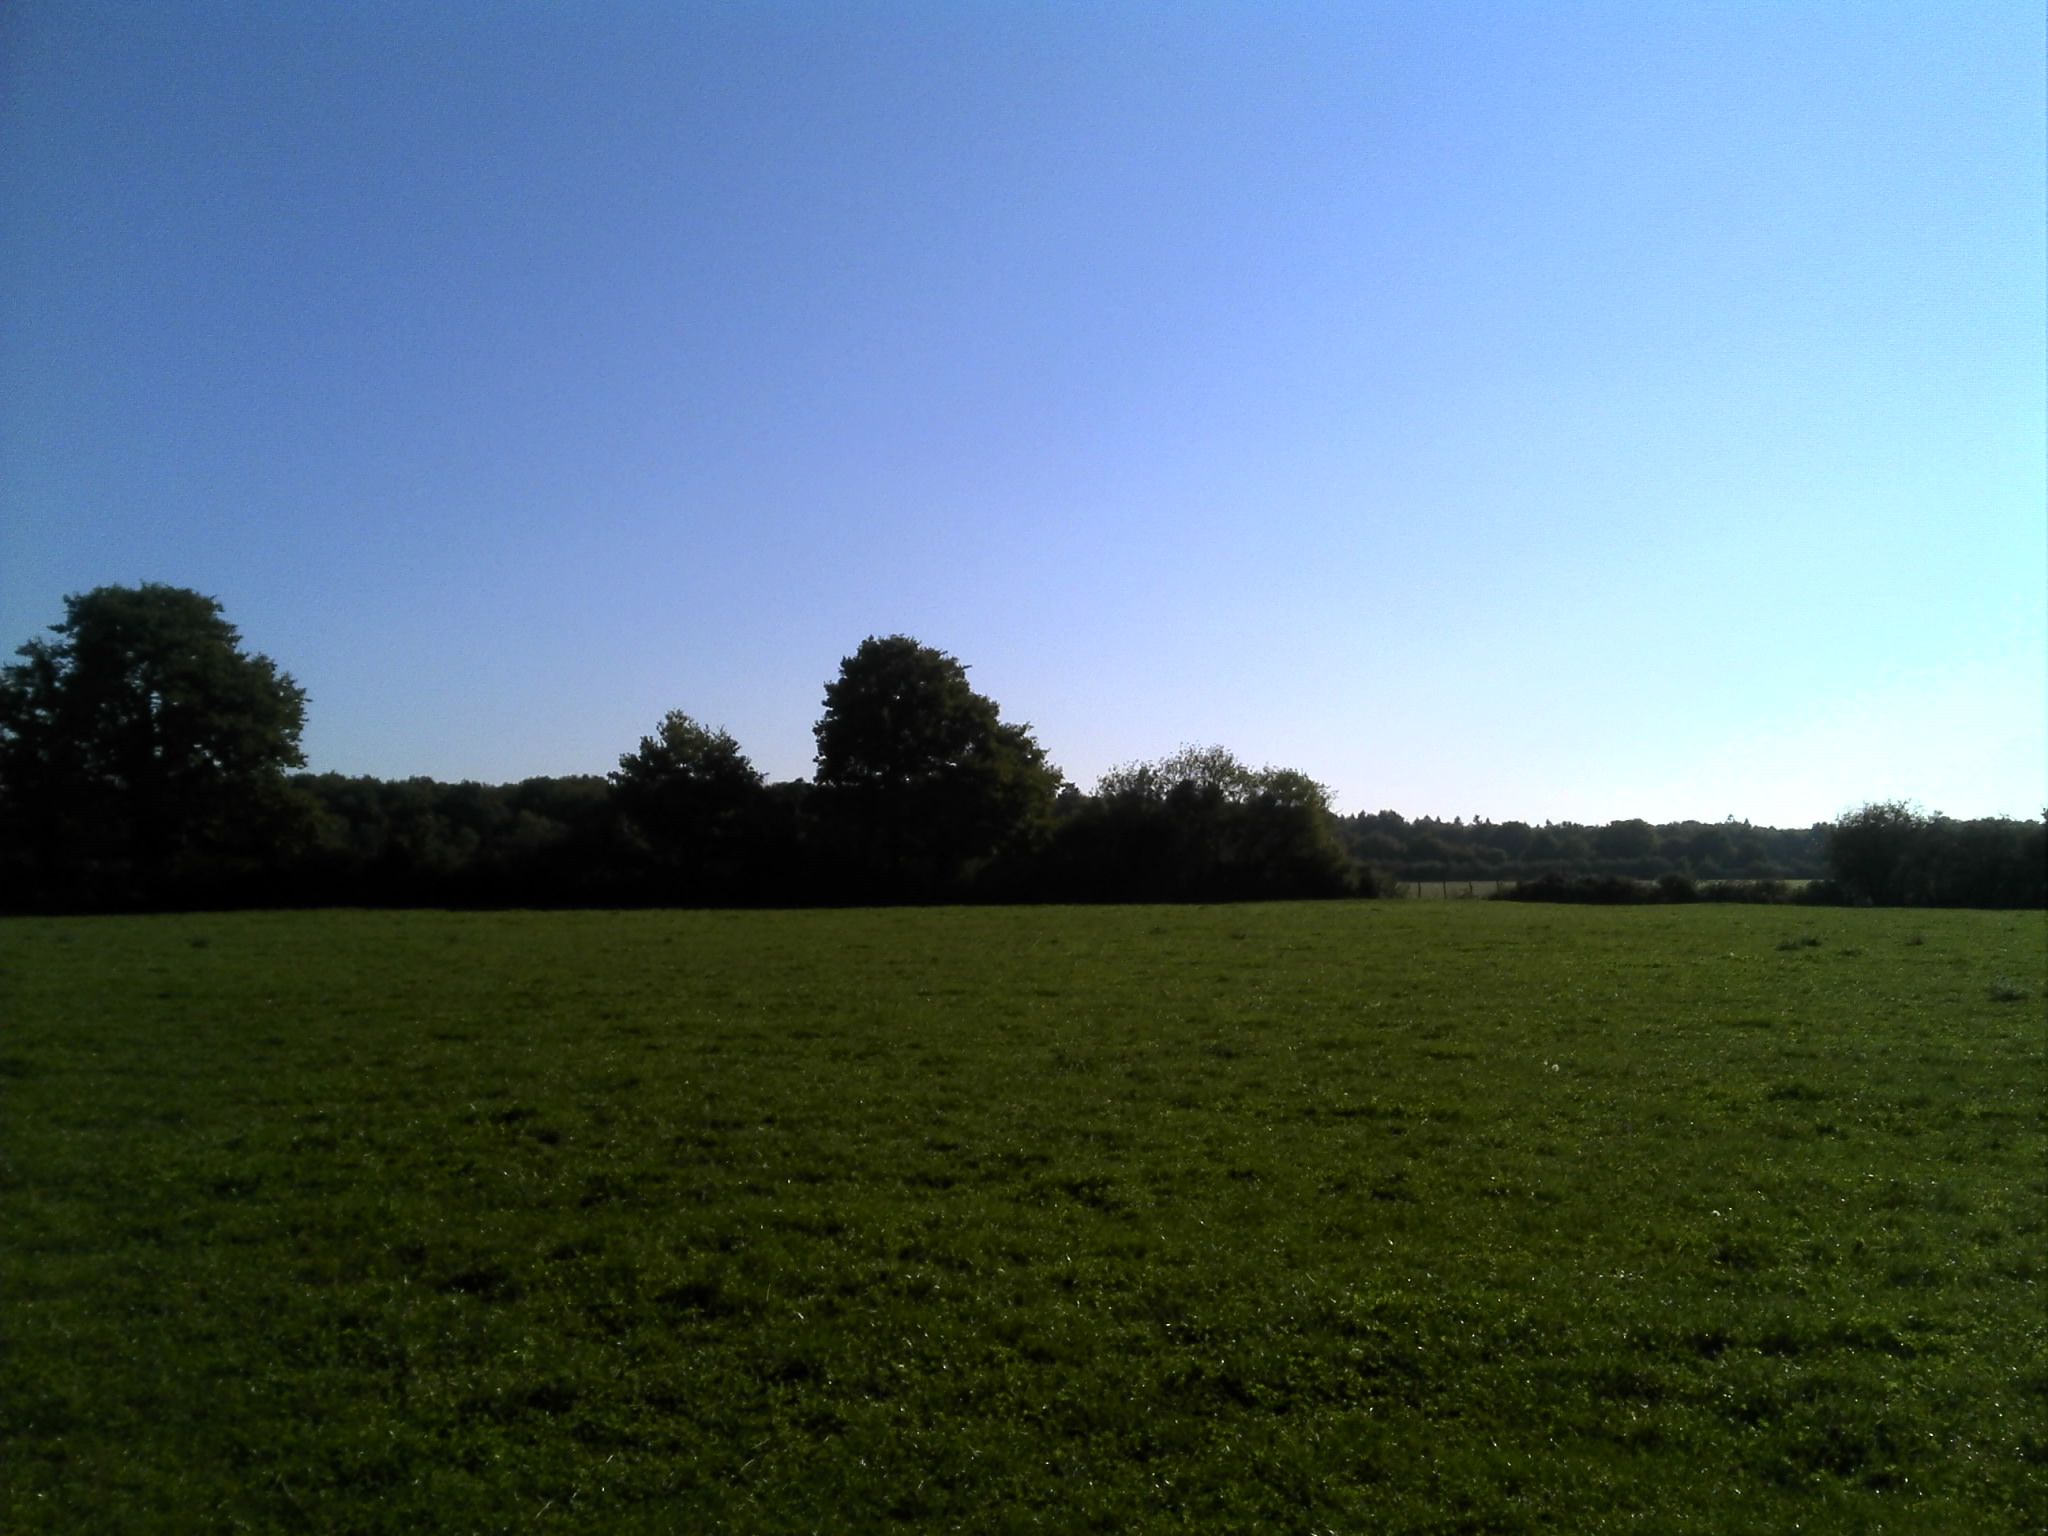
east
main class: Grassland
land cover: Grassland without tree/shrub cover
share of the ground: > 75 %
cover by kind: herbaceous plants 100 %
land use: Agriculture (excluding fallow land and kitchen gardens)
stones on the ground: < 10 %
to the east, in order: Grassland without tree/shrub cover; Fences; Abandoned hedges; Fences; Grassland without tree/shrub cover; Fences; Abandoned hedges; Common wheat
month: October
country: FR
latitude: 47.6128
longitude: -1.0397
